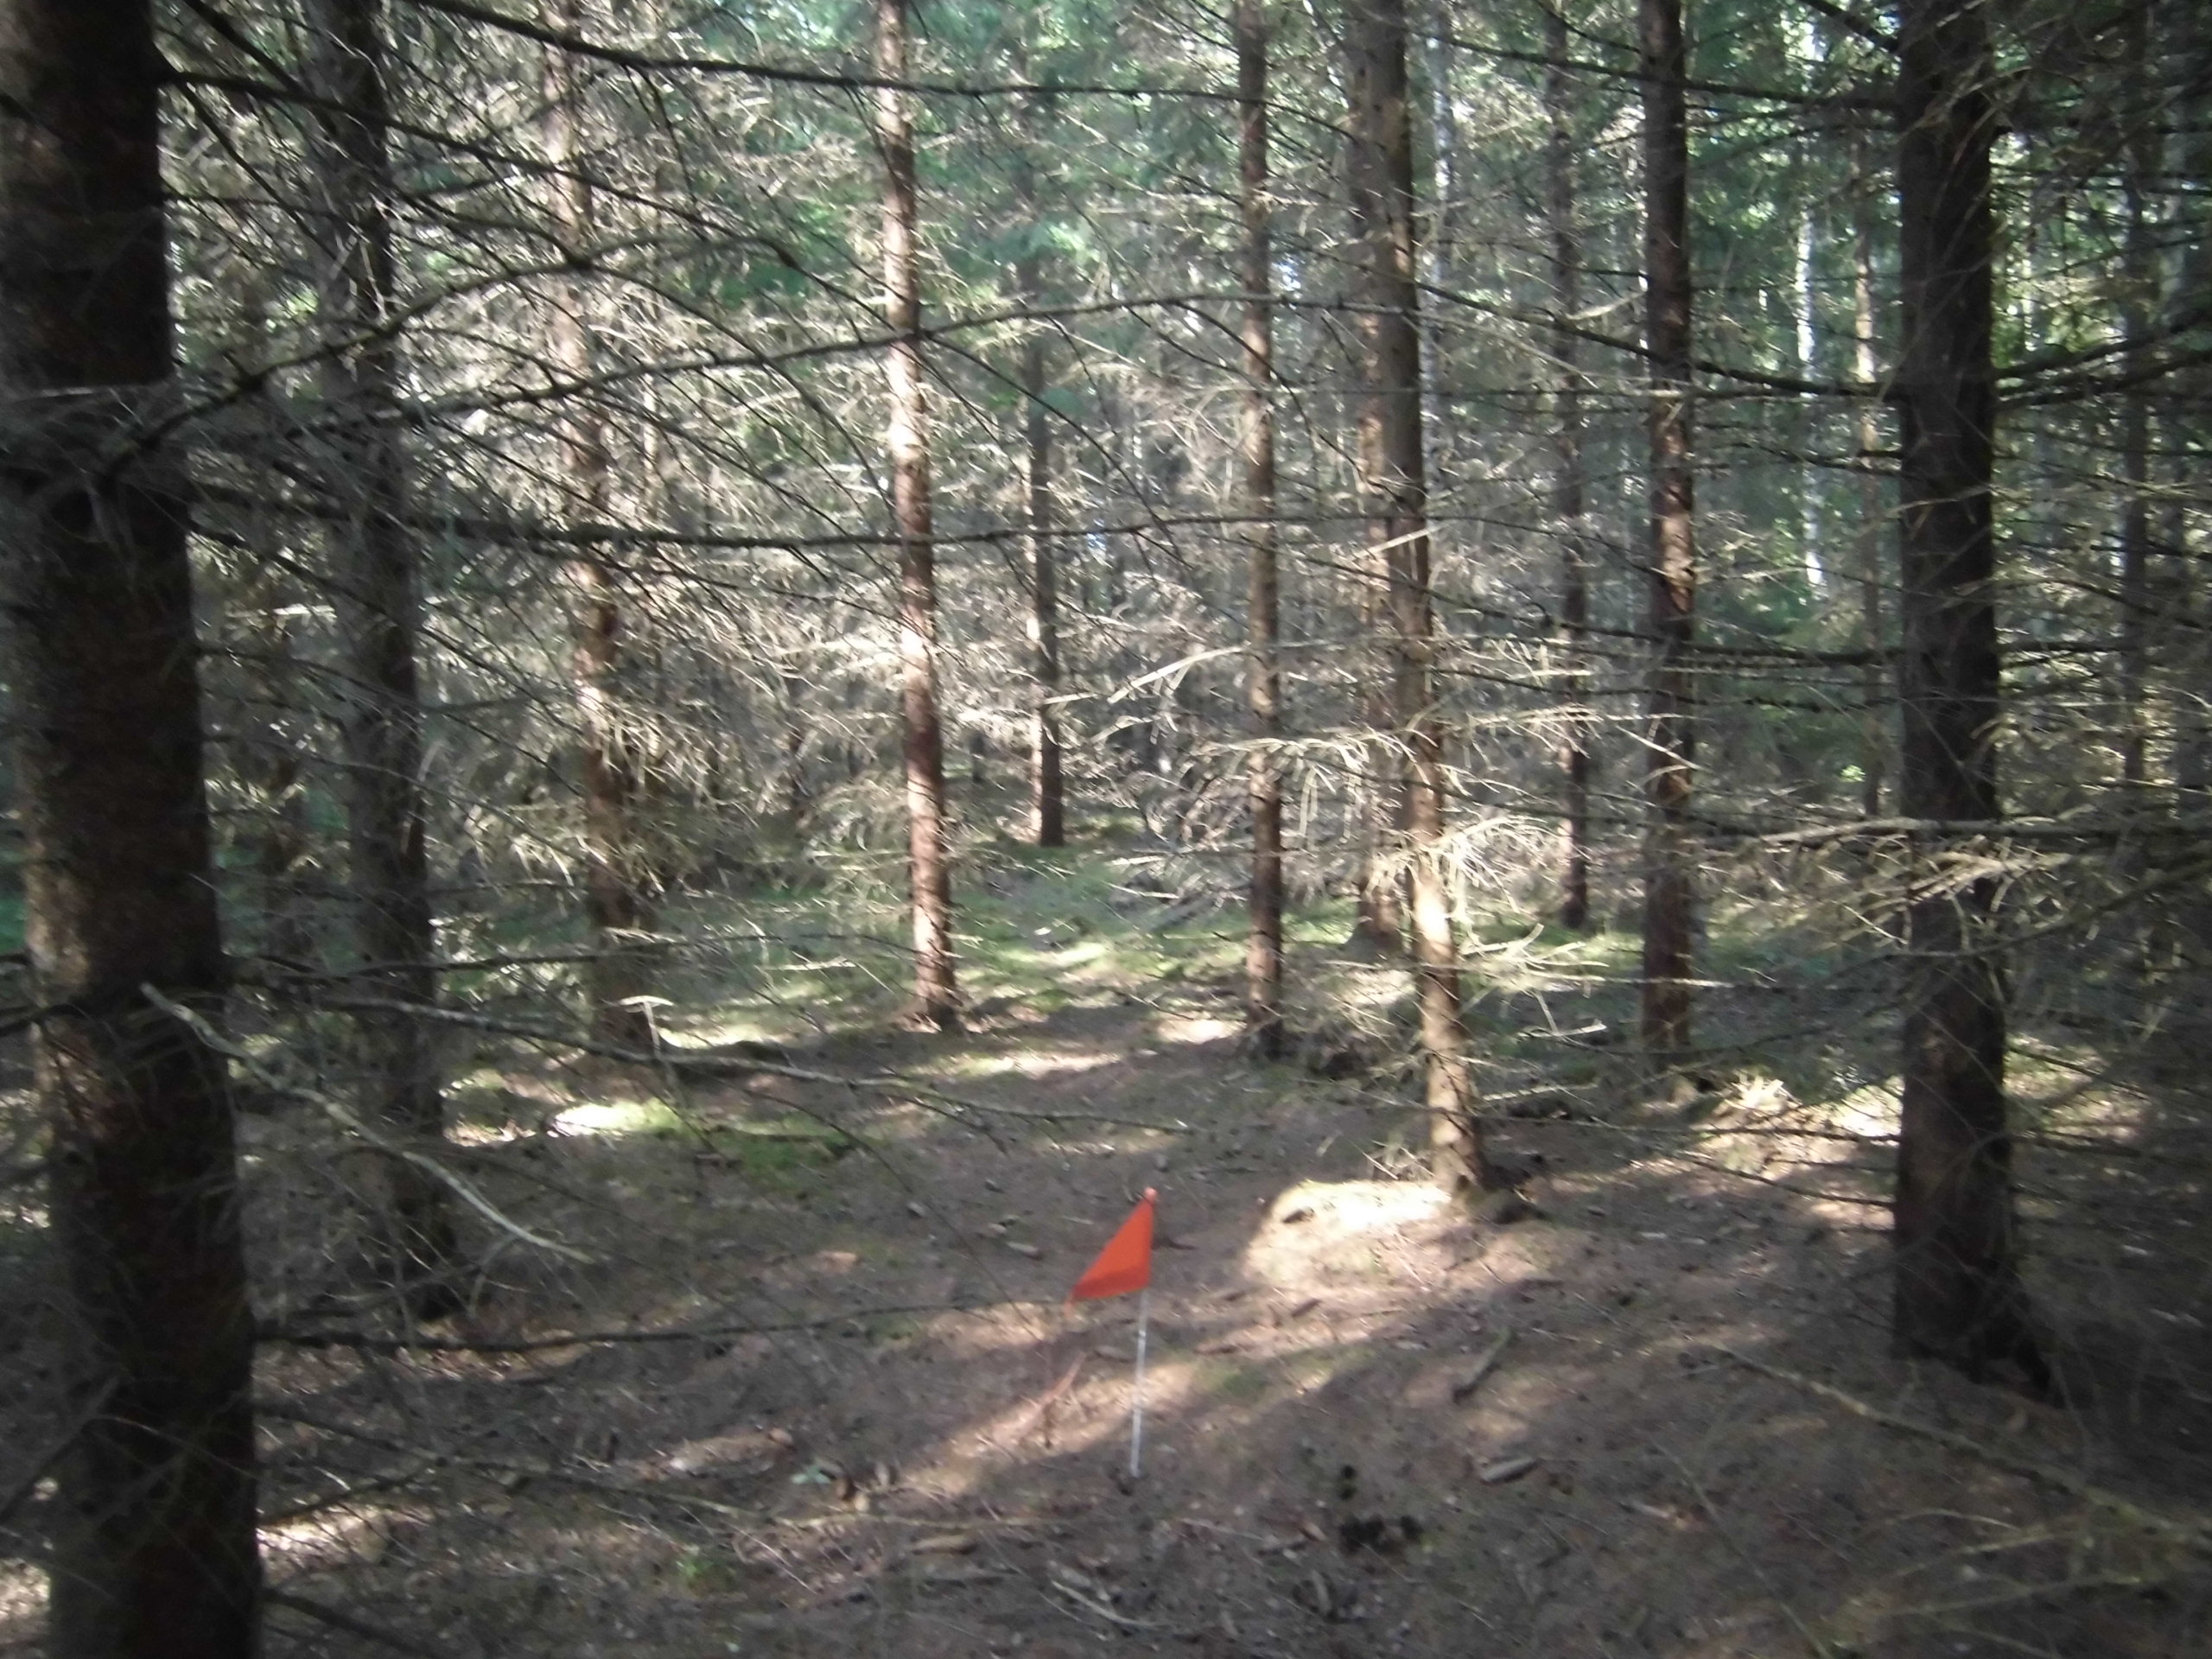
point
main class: Woodland
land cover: Spruce dominated coniferous woodland
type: boreal forest
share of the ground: > 75 %
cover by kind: coniferous forest trees 75 %, unconsolidated bare surface 15 %, herbaceous plants 5 %, lichens and mosses 5 %
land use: Forestry
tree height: > 5 m
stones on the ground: 10 - 25 %
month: July
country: SE
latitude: 57.4170
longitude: 15.1745
